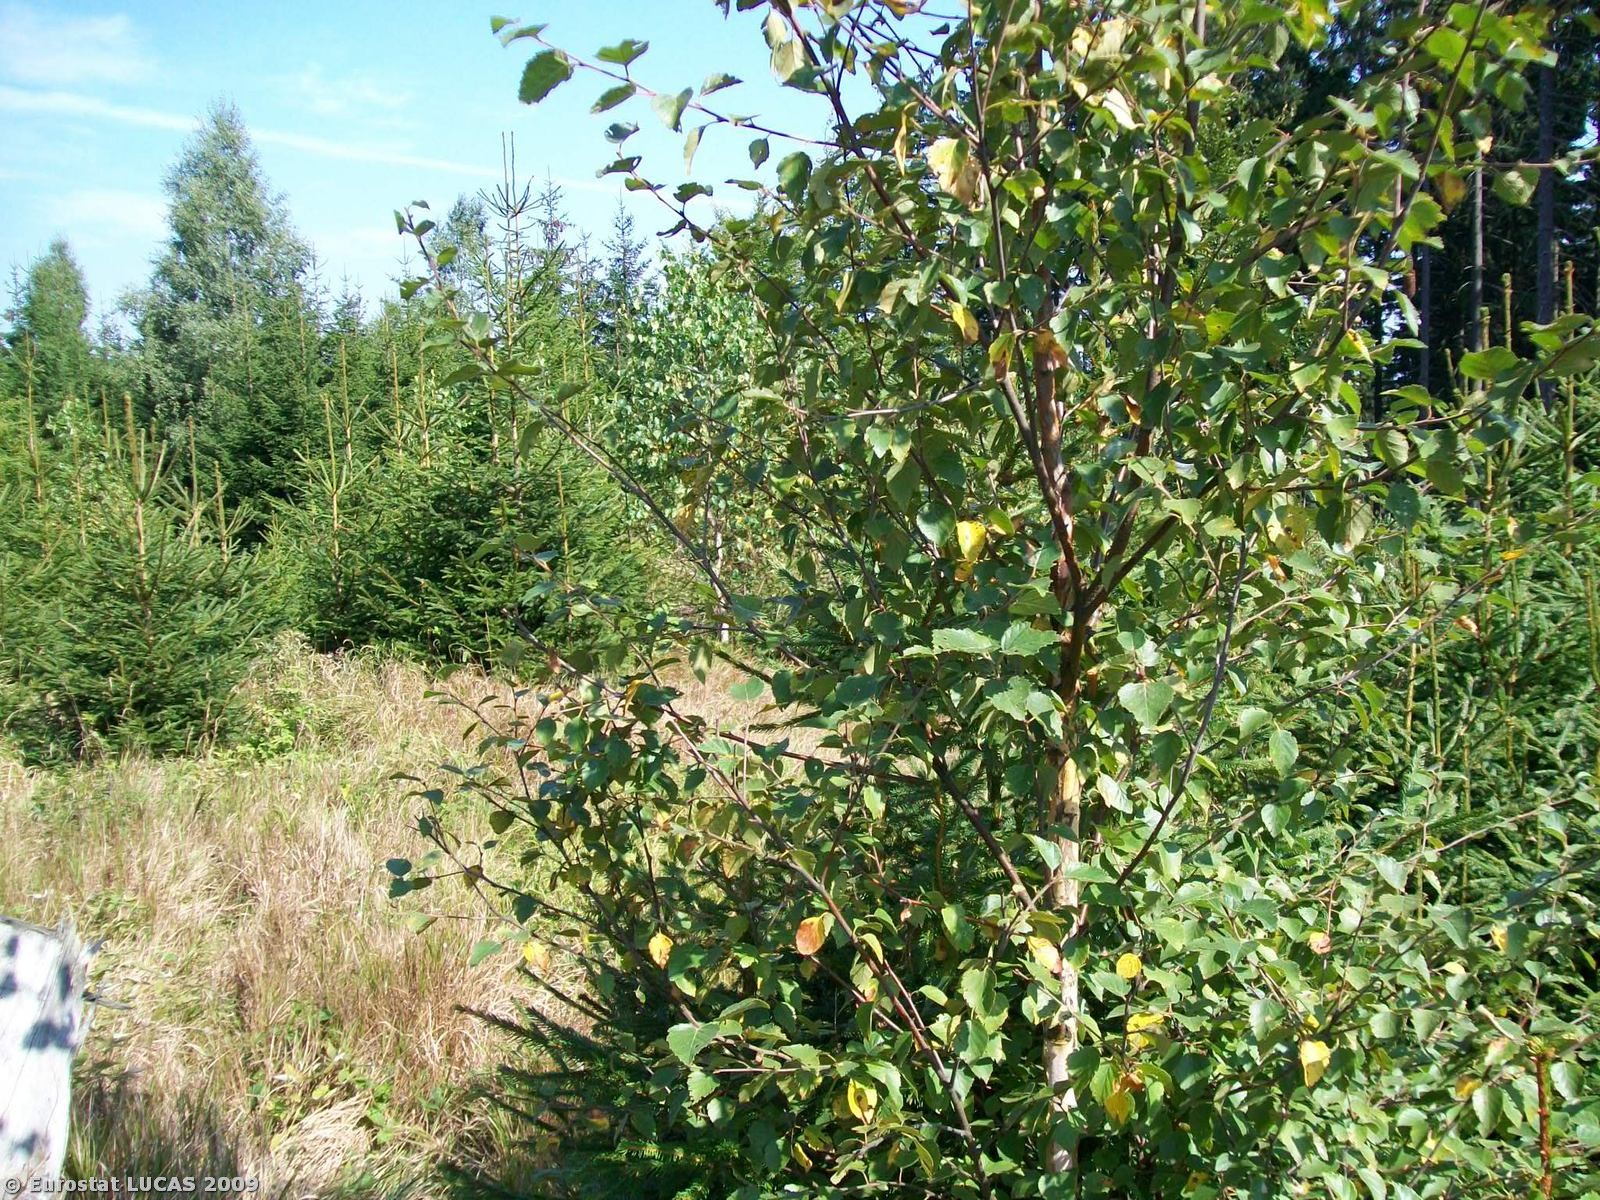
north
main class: Woodland
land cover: Mixed woodland
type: hemiboreal forest and nemoral coniferous forest and mixed broadleaved-coniferous forest
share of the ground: 50 - 75 %
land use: Forestry
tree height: > 5 m
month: September
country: PL
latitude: 50.1732
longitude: 16.6028
